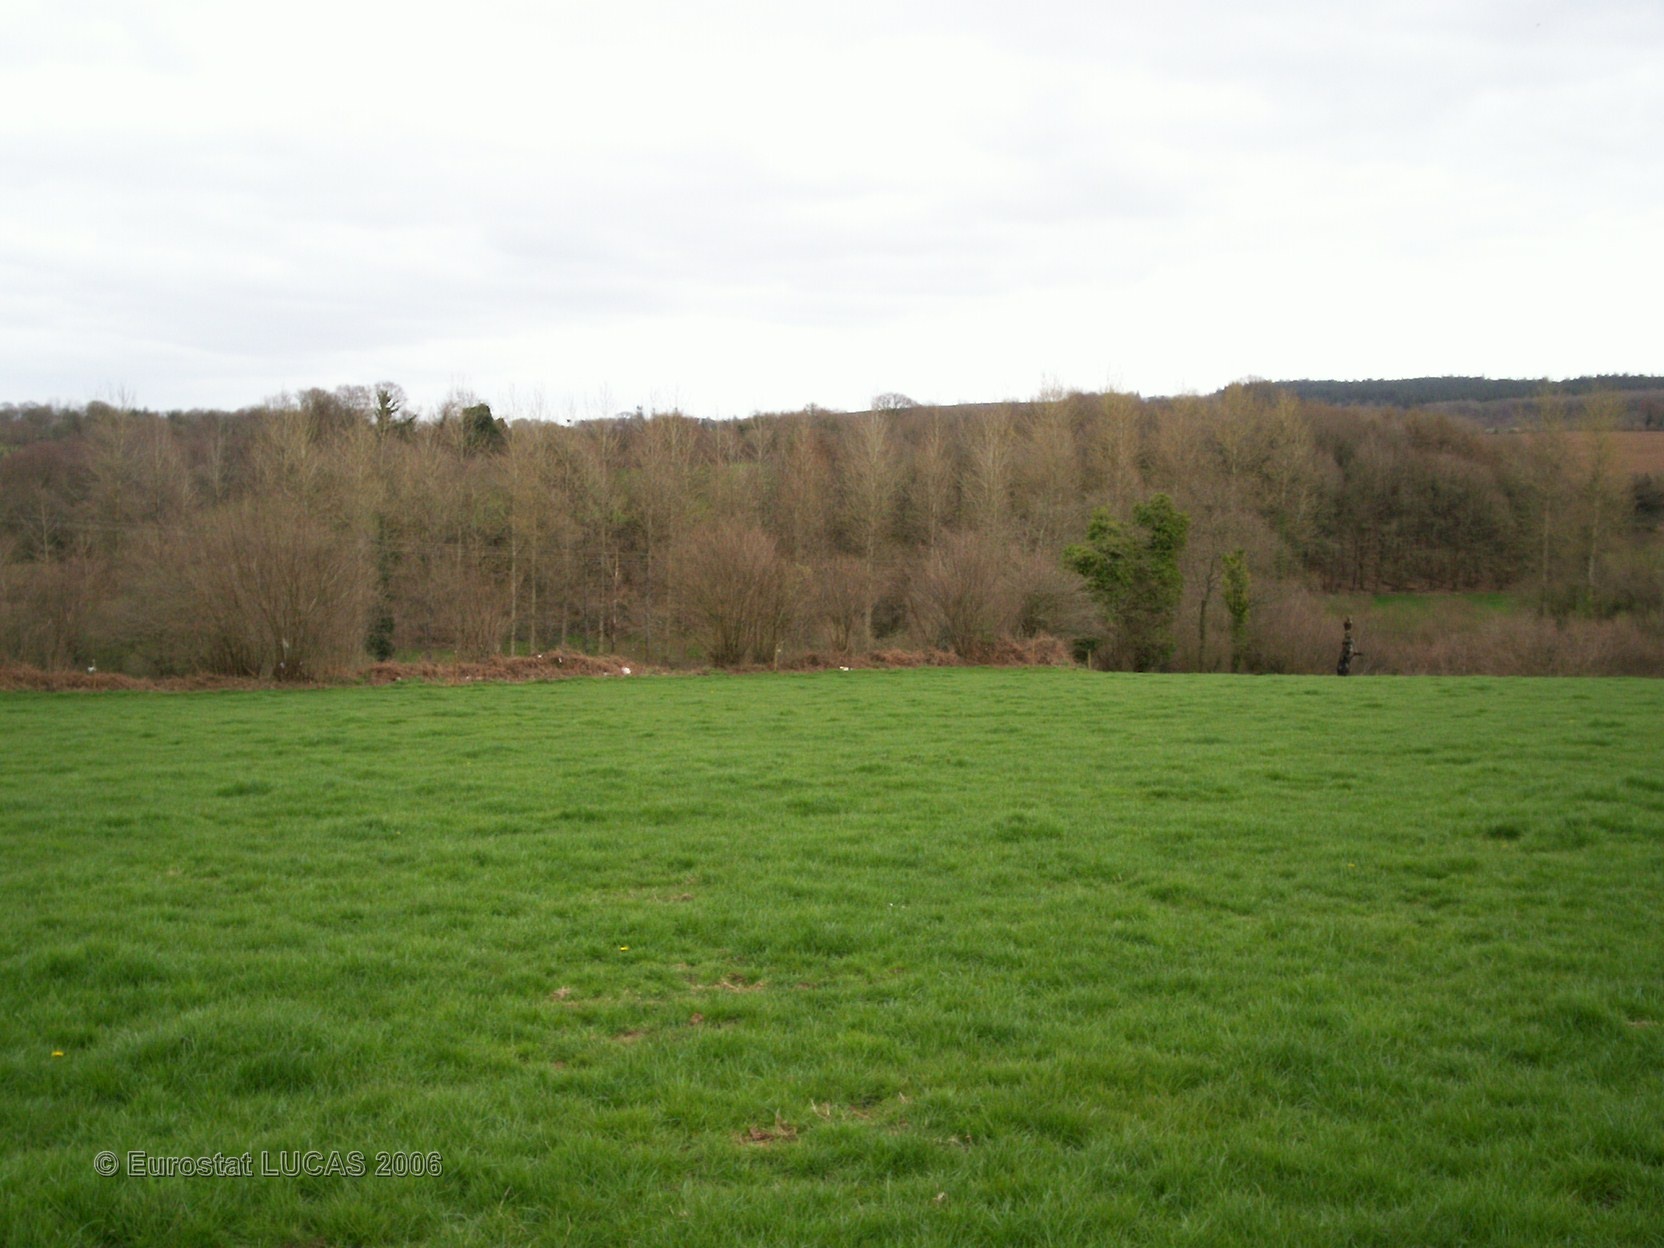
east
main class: Grassland
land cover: Grassland without tree/shrub cover
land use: Agriculture (excluding fallow land and kitchen gardens)
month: April
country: FR
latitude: 48.1935
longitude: -3.6270
